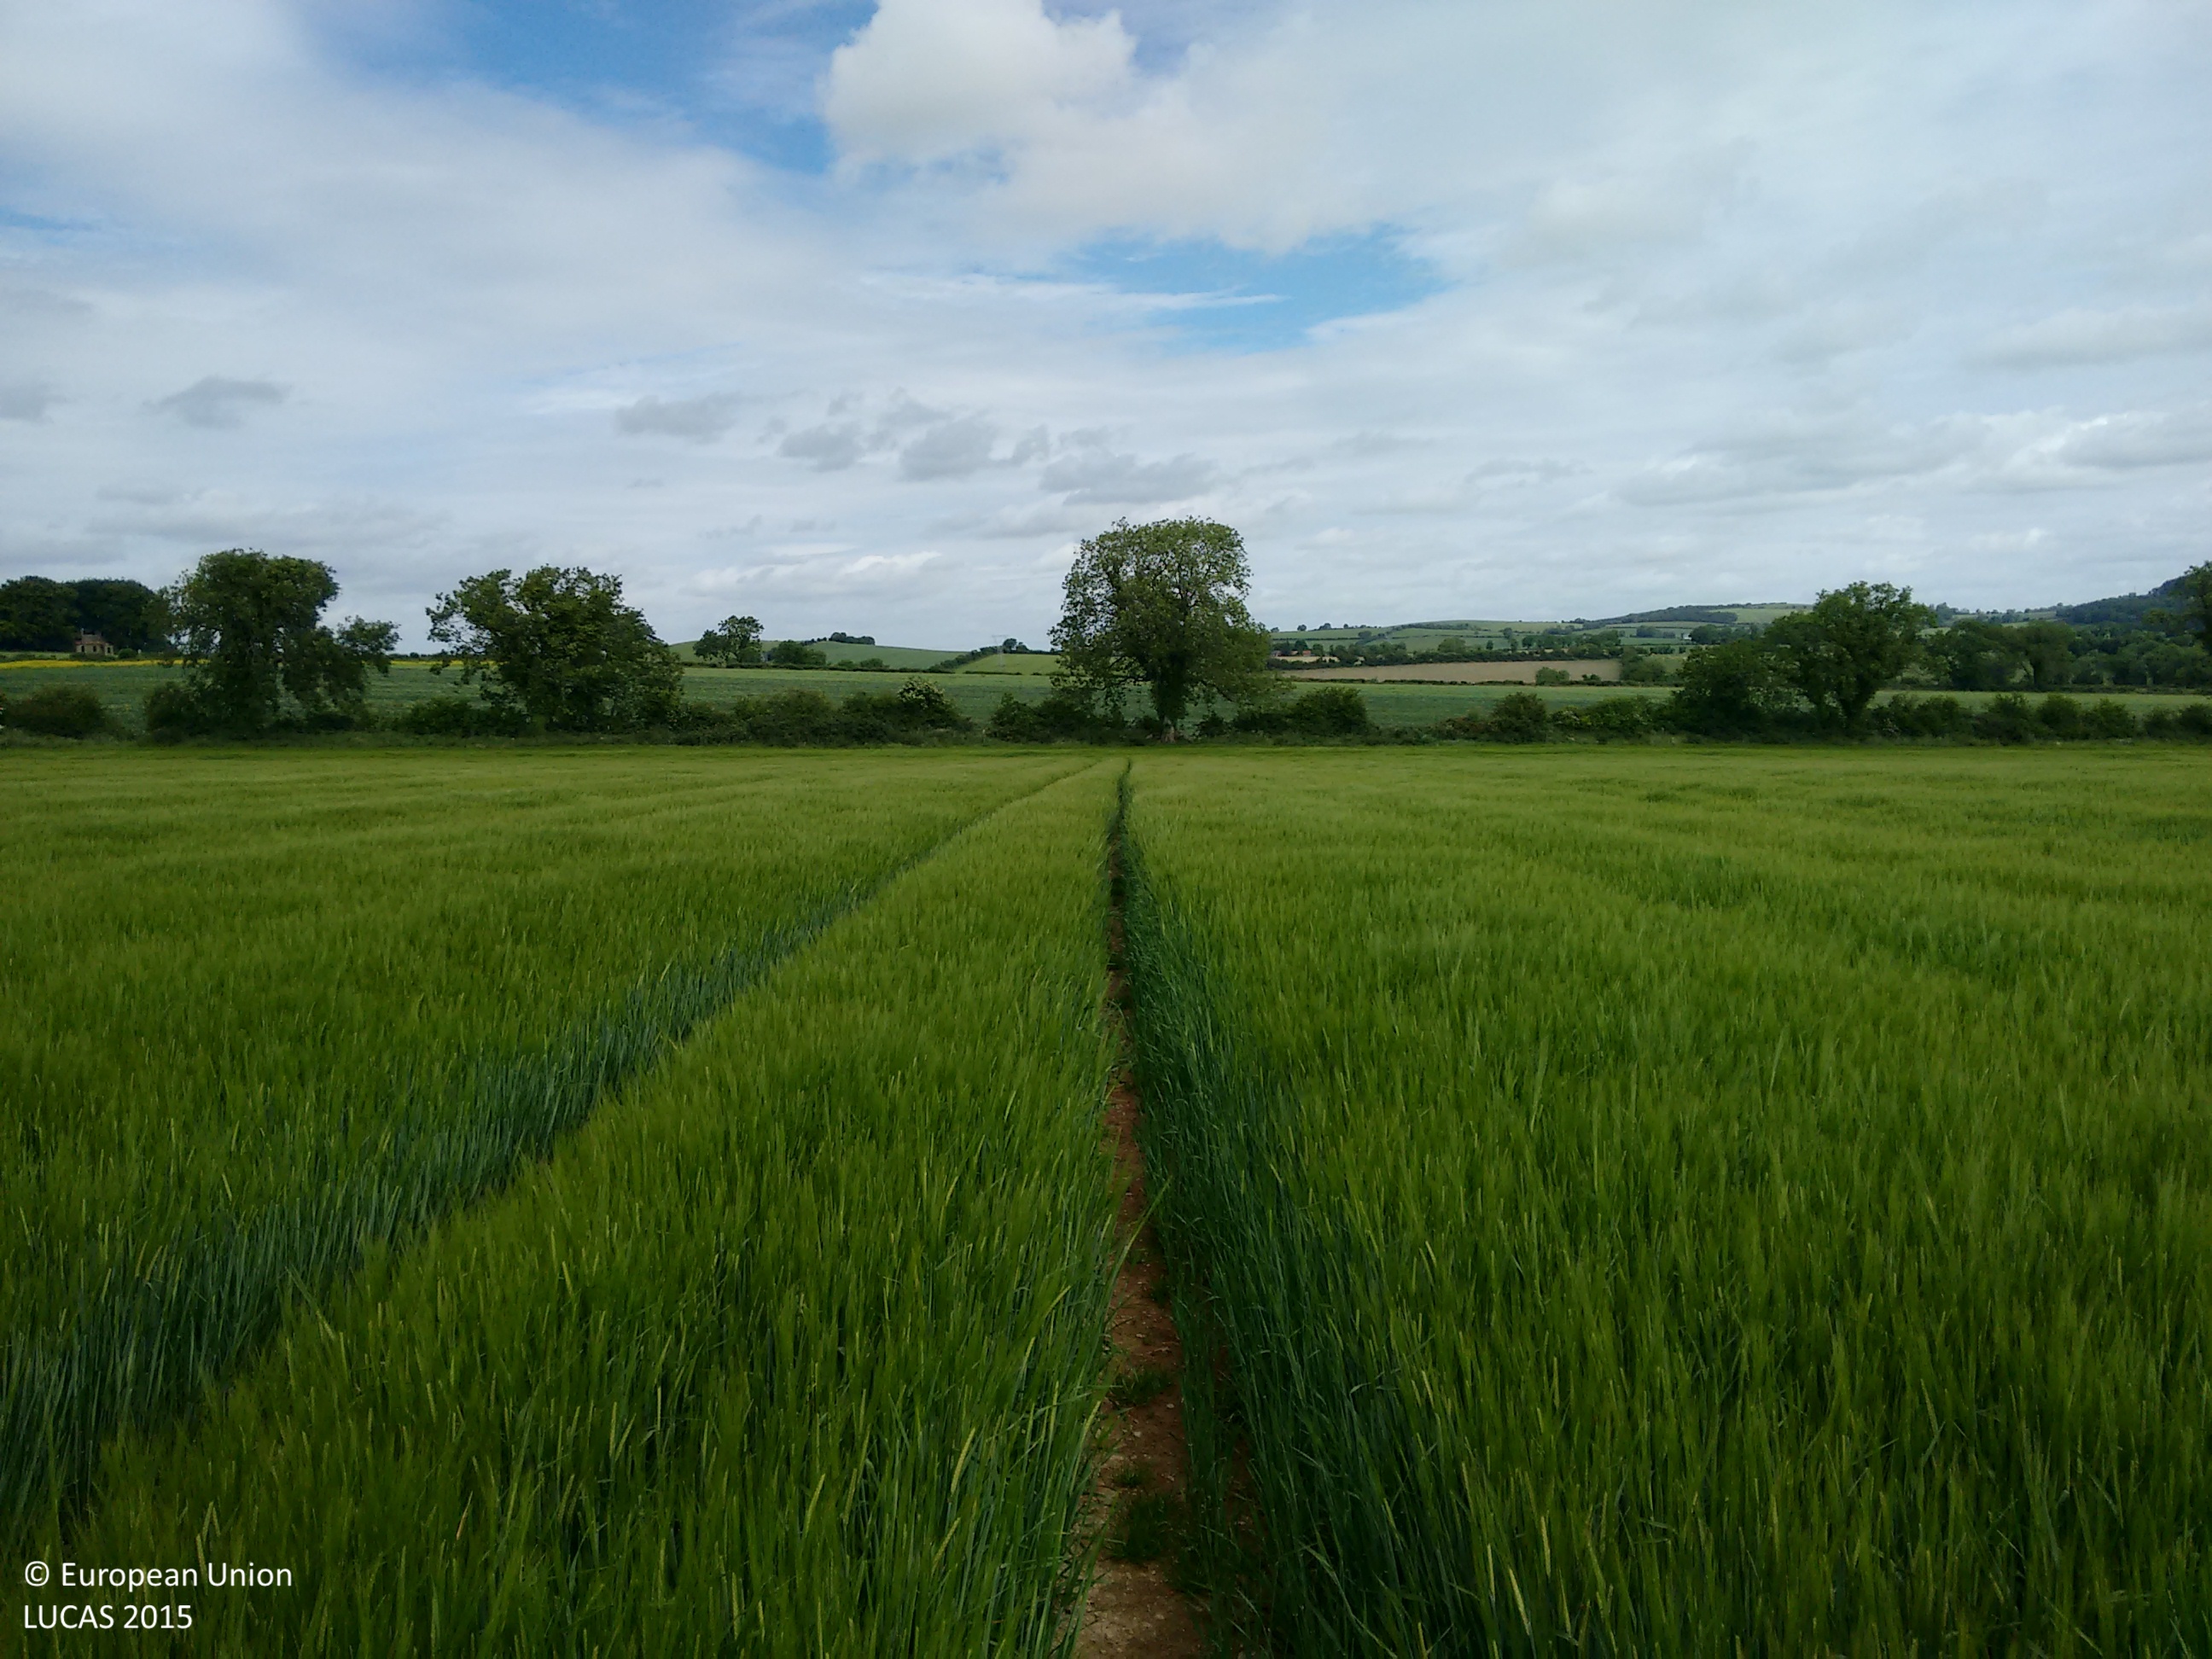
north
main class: Cropland
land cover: Barley
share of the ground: > 75 %
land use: Agriculture (excluding fallow land and kitchen gardens)
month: June
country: IE
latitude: 53.7285
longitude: -6.6364
